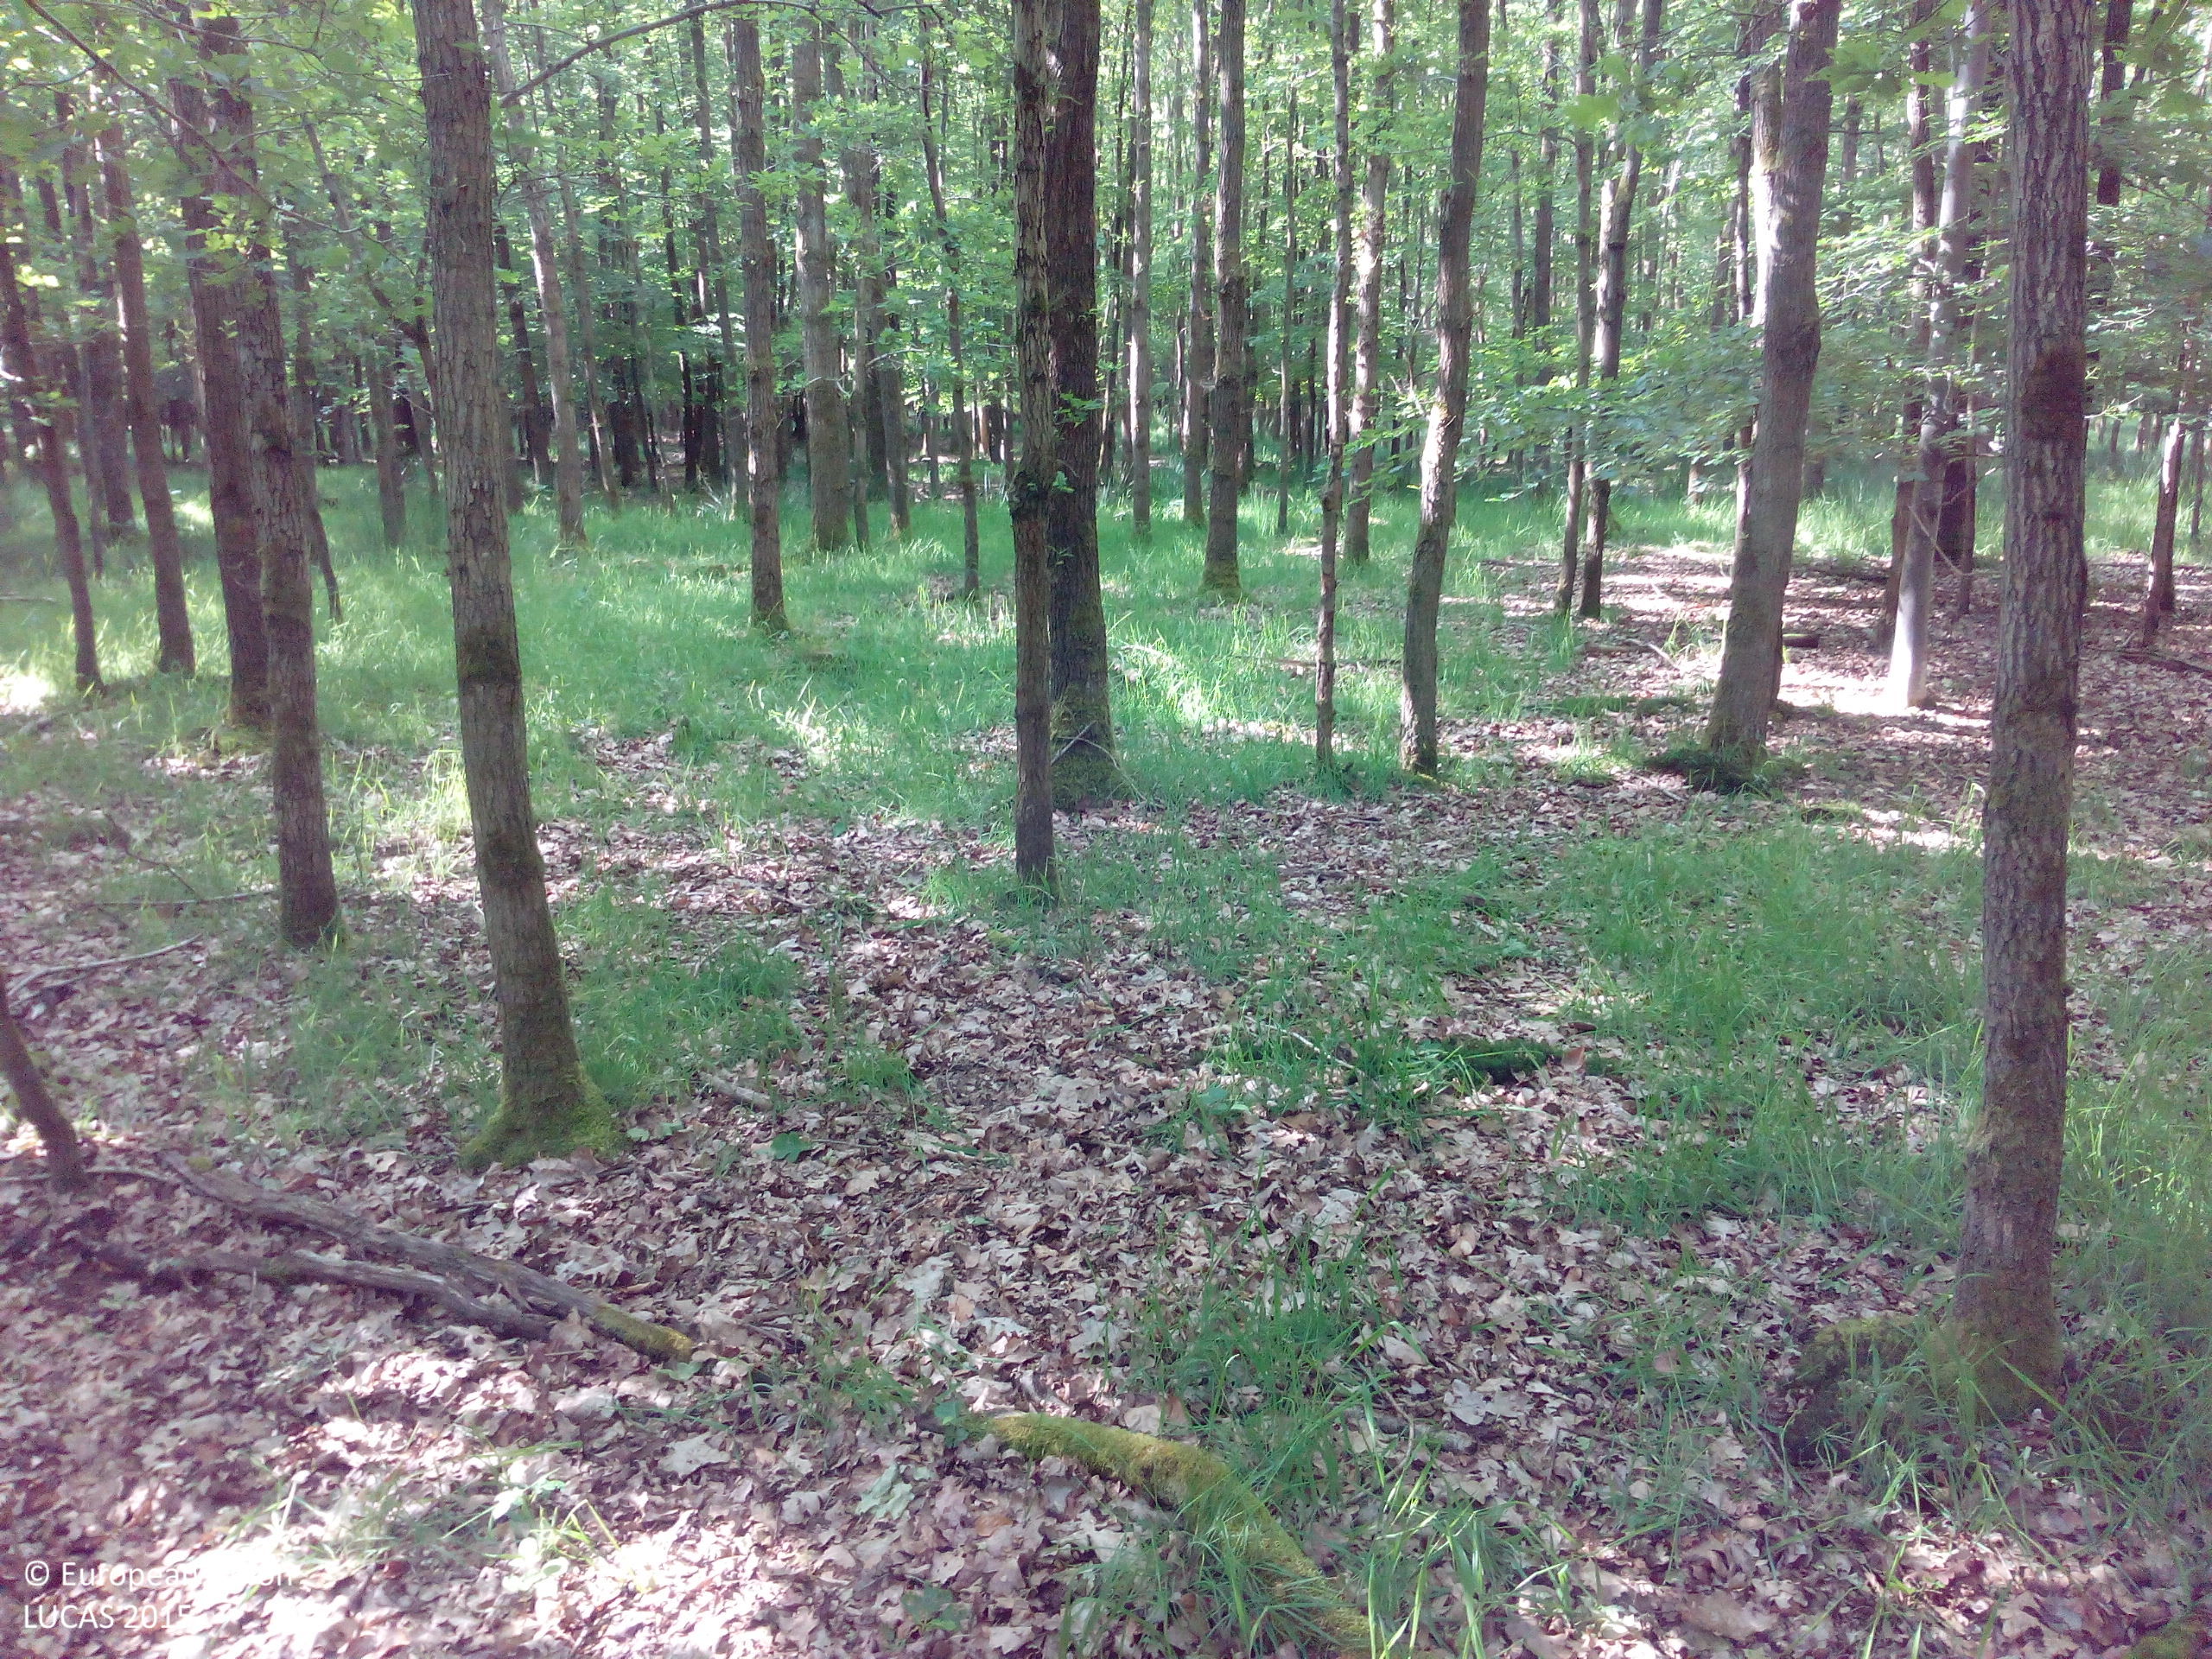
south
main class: Woodland
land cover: Broadleaved woodland
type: mesophytic deciduous forest
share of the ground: > 75 %
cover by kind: broadleaved forest trees 75 %, herbaceous plants 15 %, unconsolidated bare surface 10 %
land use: Forestry
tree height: > 5 m
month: May
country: DE
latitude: 49.9590
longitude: 8.5368
